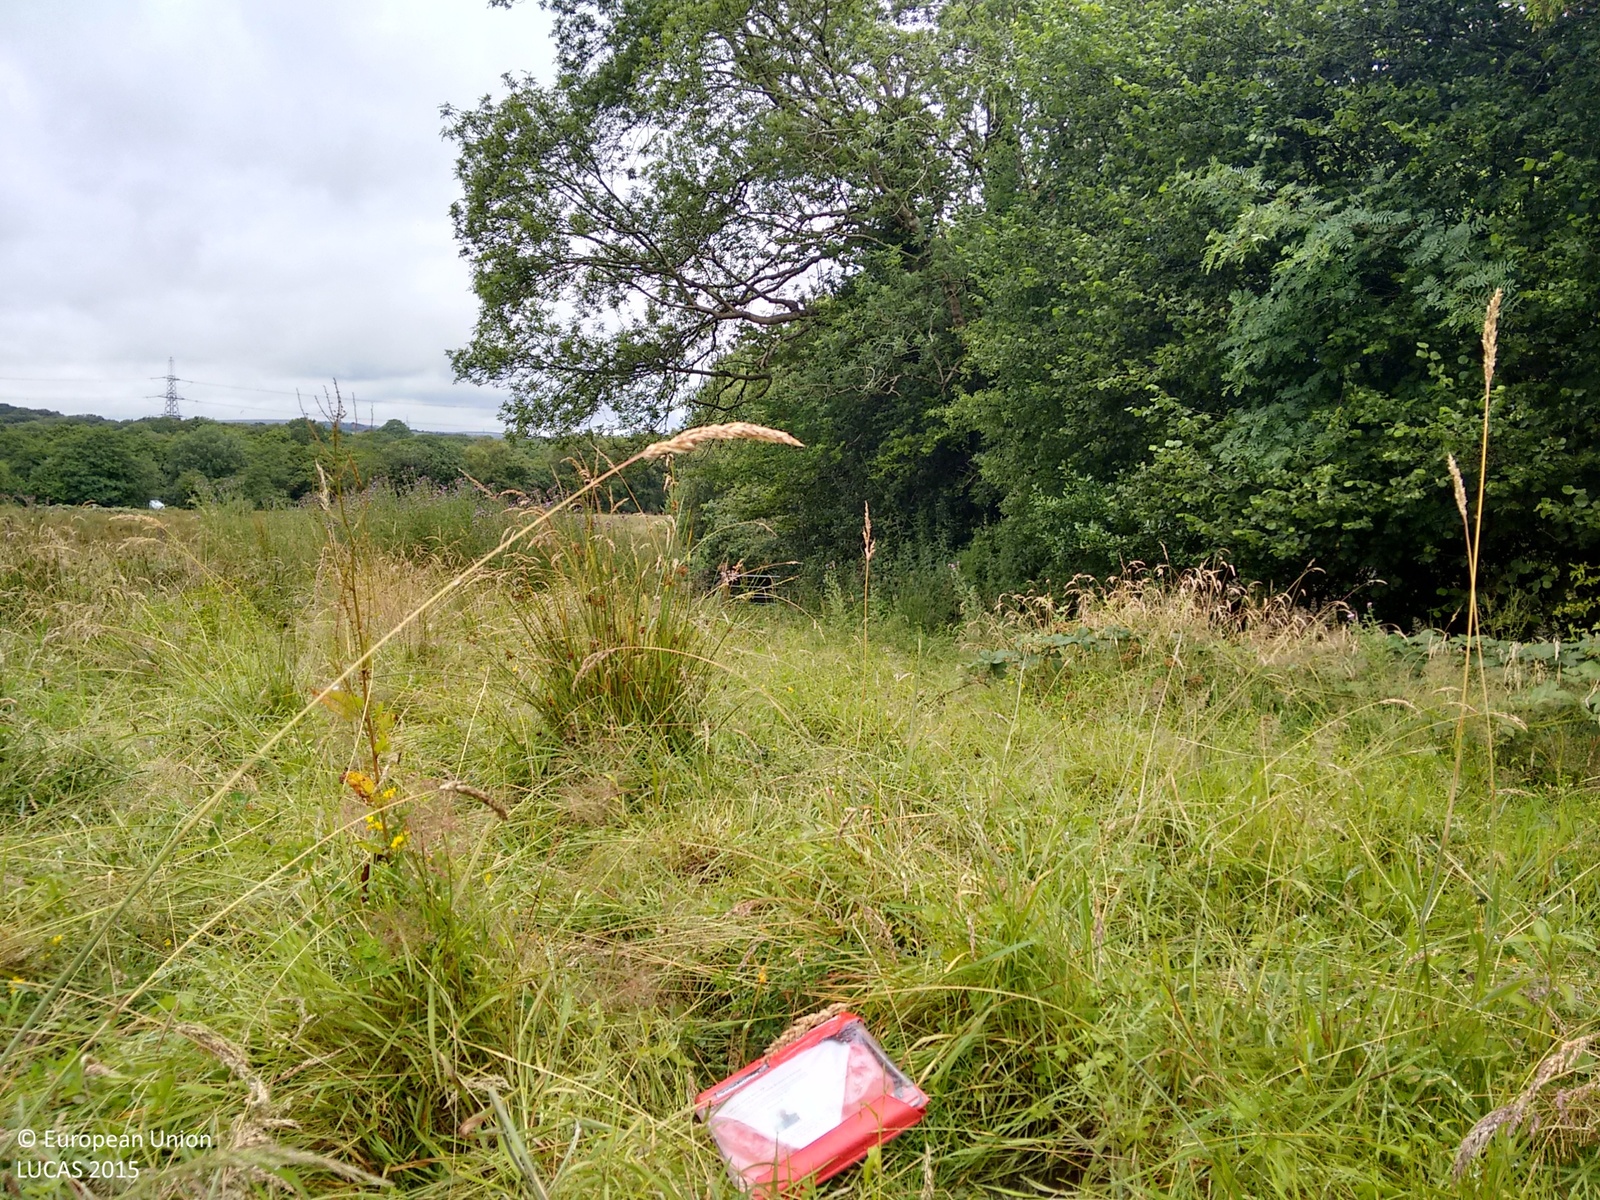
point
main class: Grassland
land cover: Grassland without tree/shrub cover
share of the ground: > 75 %
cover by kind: herbaceous plants 100 %
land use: Agriculture (excluding fallow land and kitchen gardens)
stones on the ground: < 10 %
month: July
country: GB
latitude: 51.6917
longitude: -3.8195
